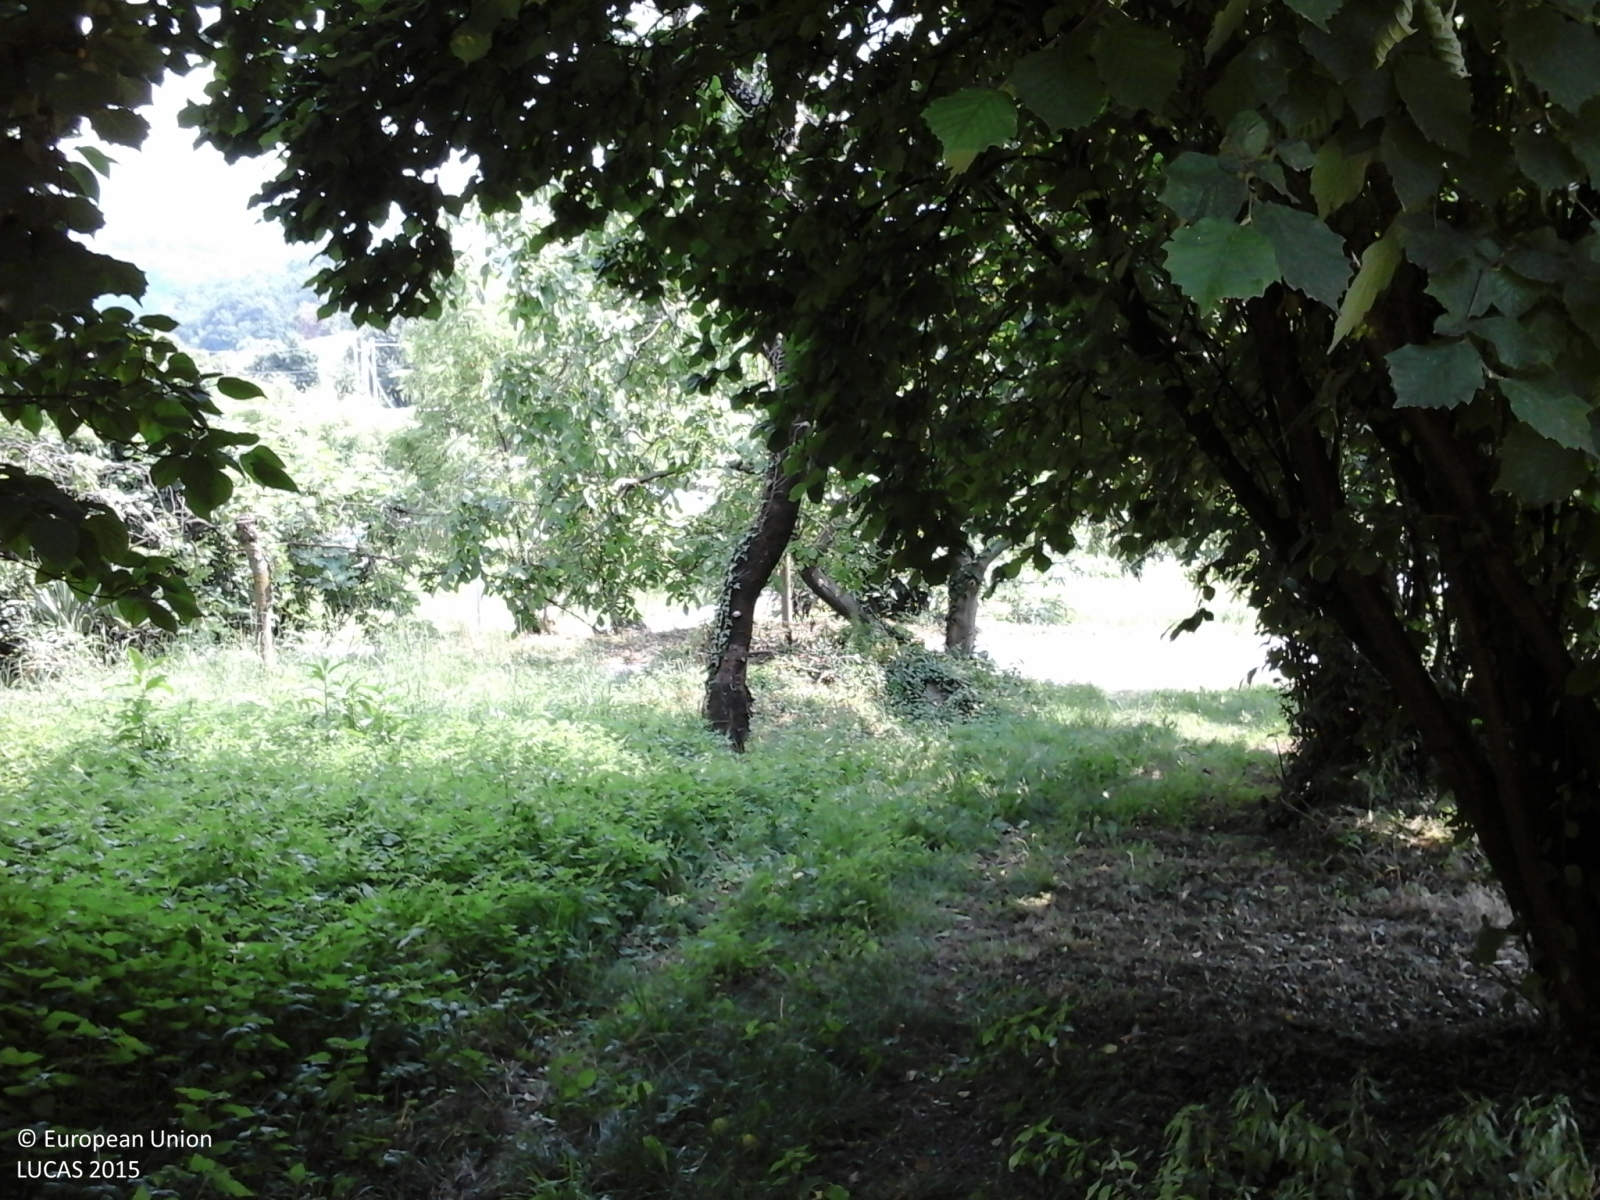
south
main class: Woodland
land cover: Broadleaved woodland
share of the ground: > 75 %
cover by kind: broadleaved forest trees 100 %
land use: Agriculture (excluding fallow land and kitchen gardens)
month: June
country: IT
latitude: 45.7445
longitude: 11.6042
